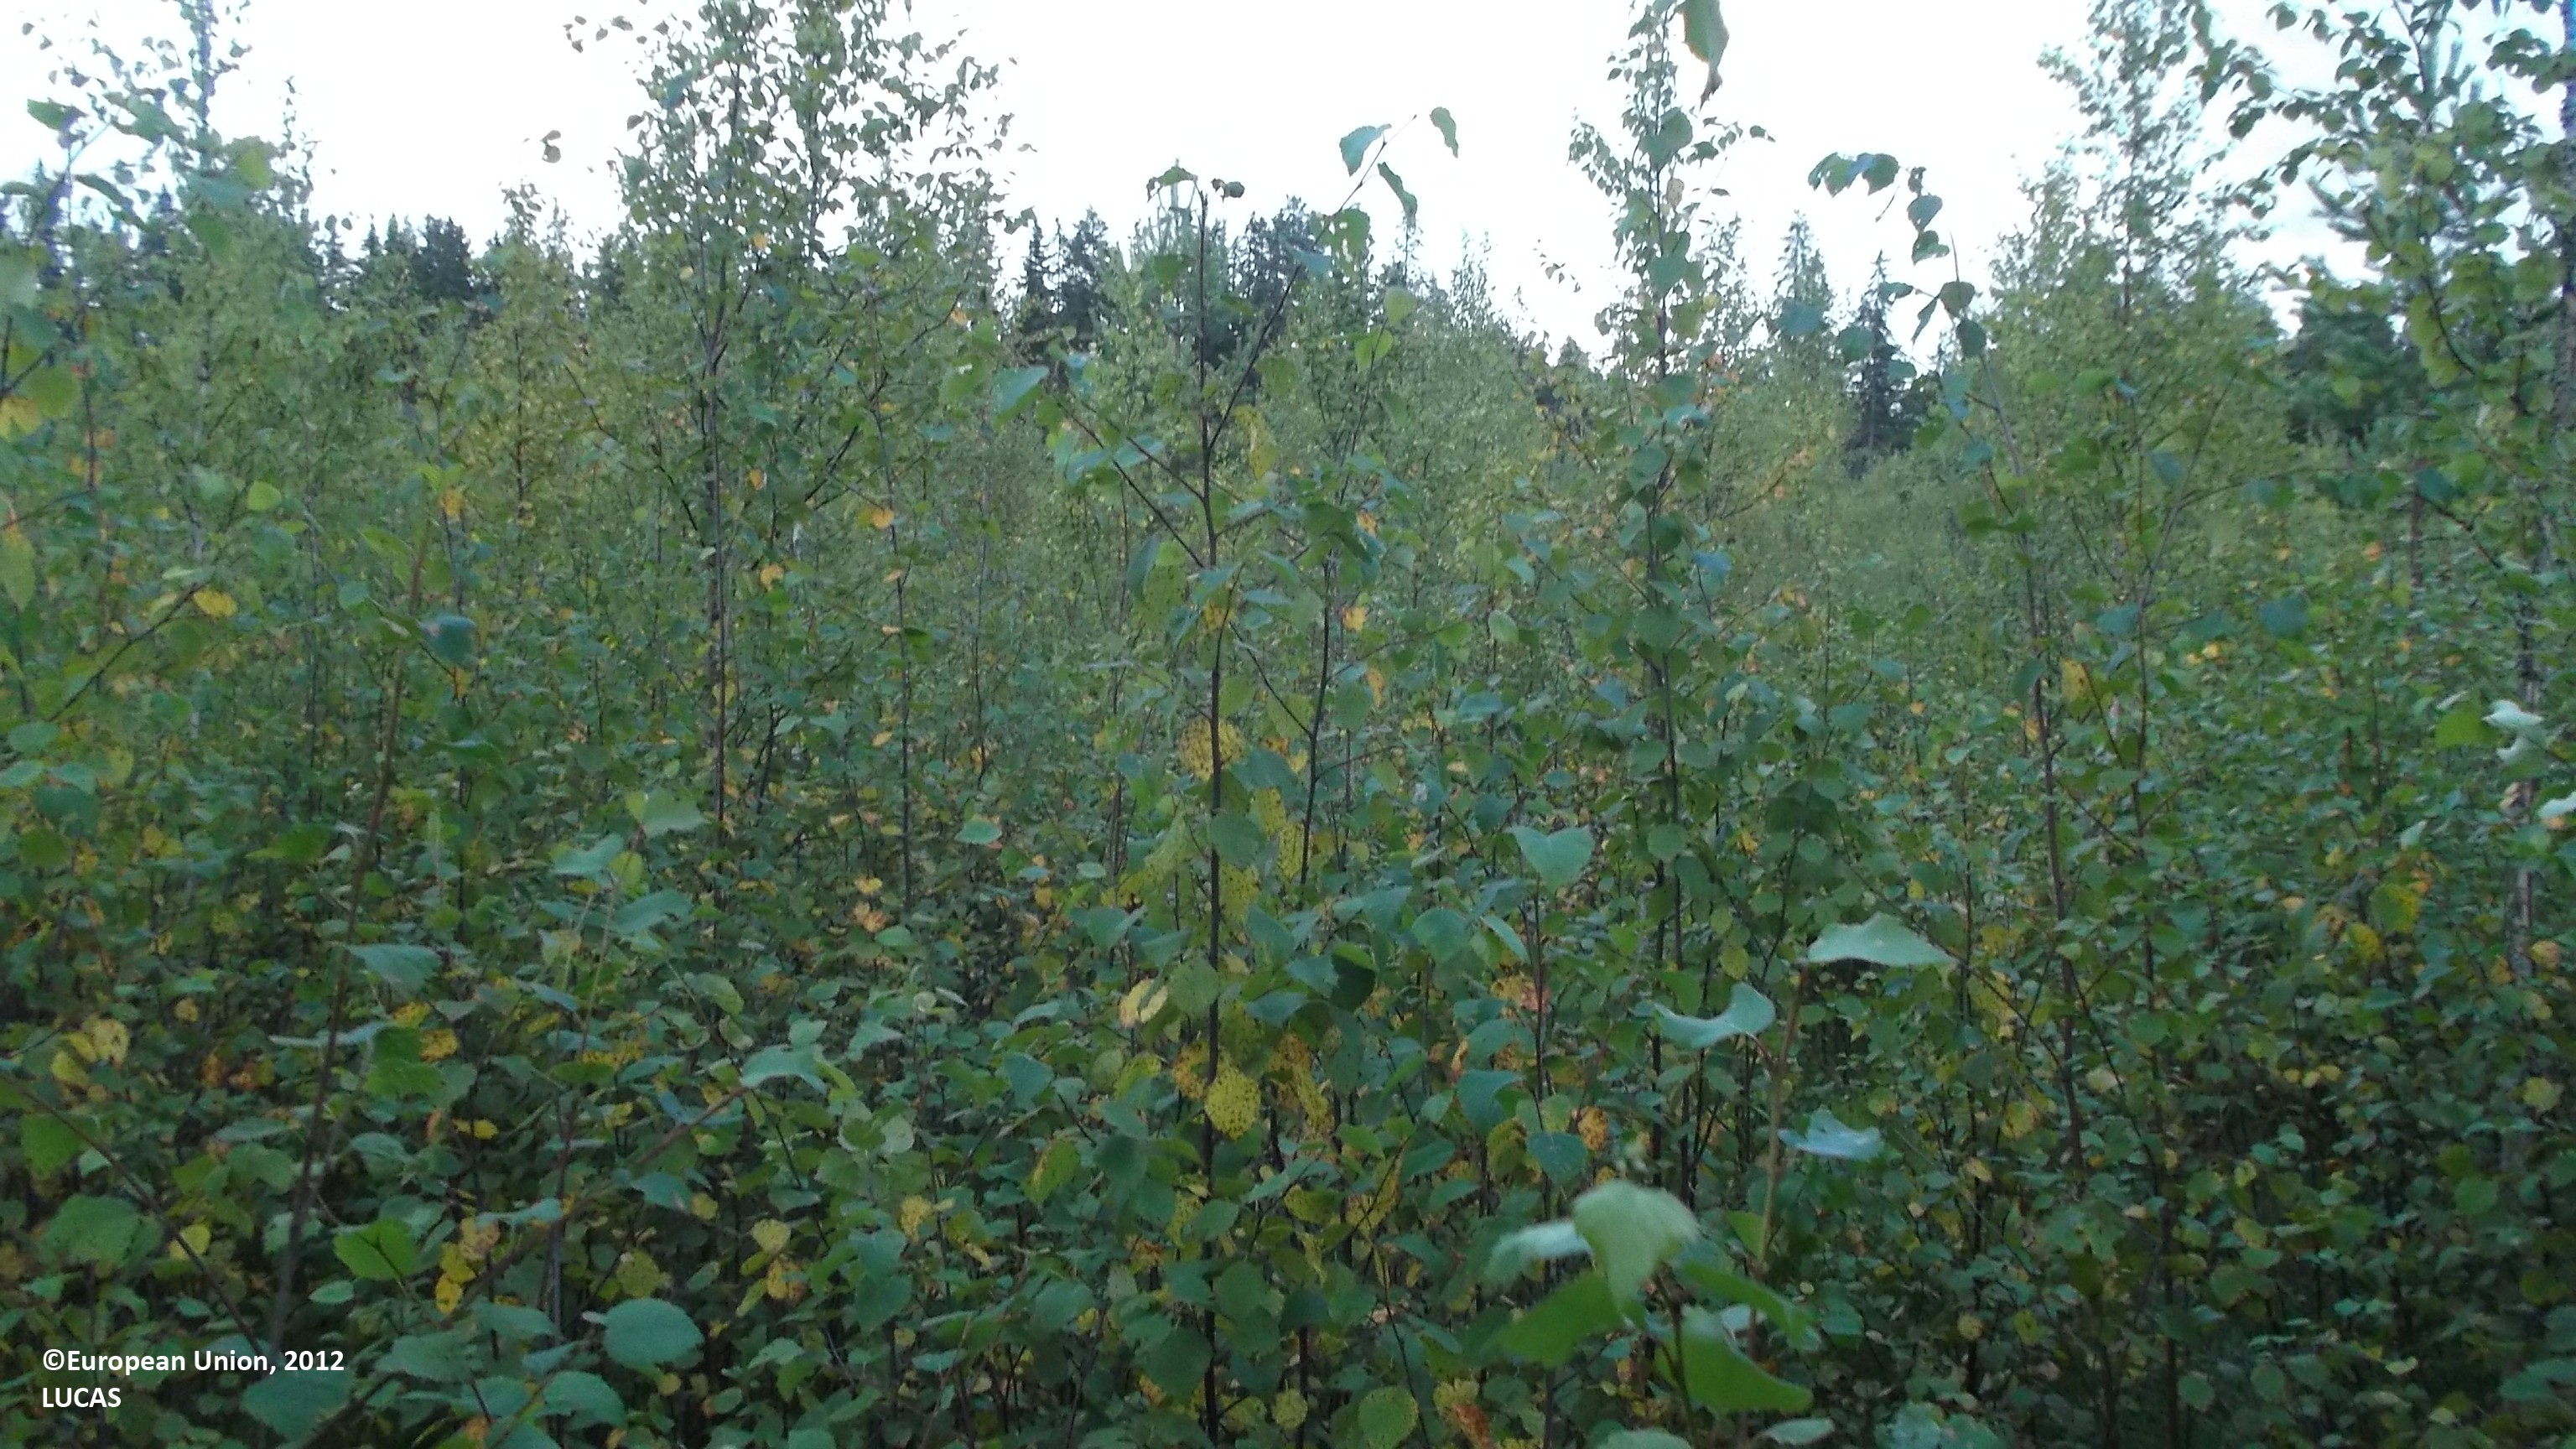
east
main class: Woodland
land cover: Broadleaved woodland
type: boreal forest
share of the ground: 25 - 50 %
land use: Forestry
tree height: < 5 m
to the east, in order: Broadleaved woodland; Ditches and canals; Broadleaved woodland; Other mixed woodland; Spruce dominated coniferous woodland; Pine dominated mixed woodland; Inland water bodies
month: August
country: FI
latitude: 63.0757
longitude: 23.7887
